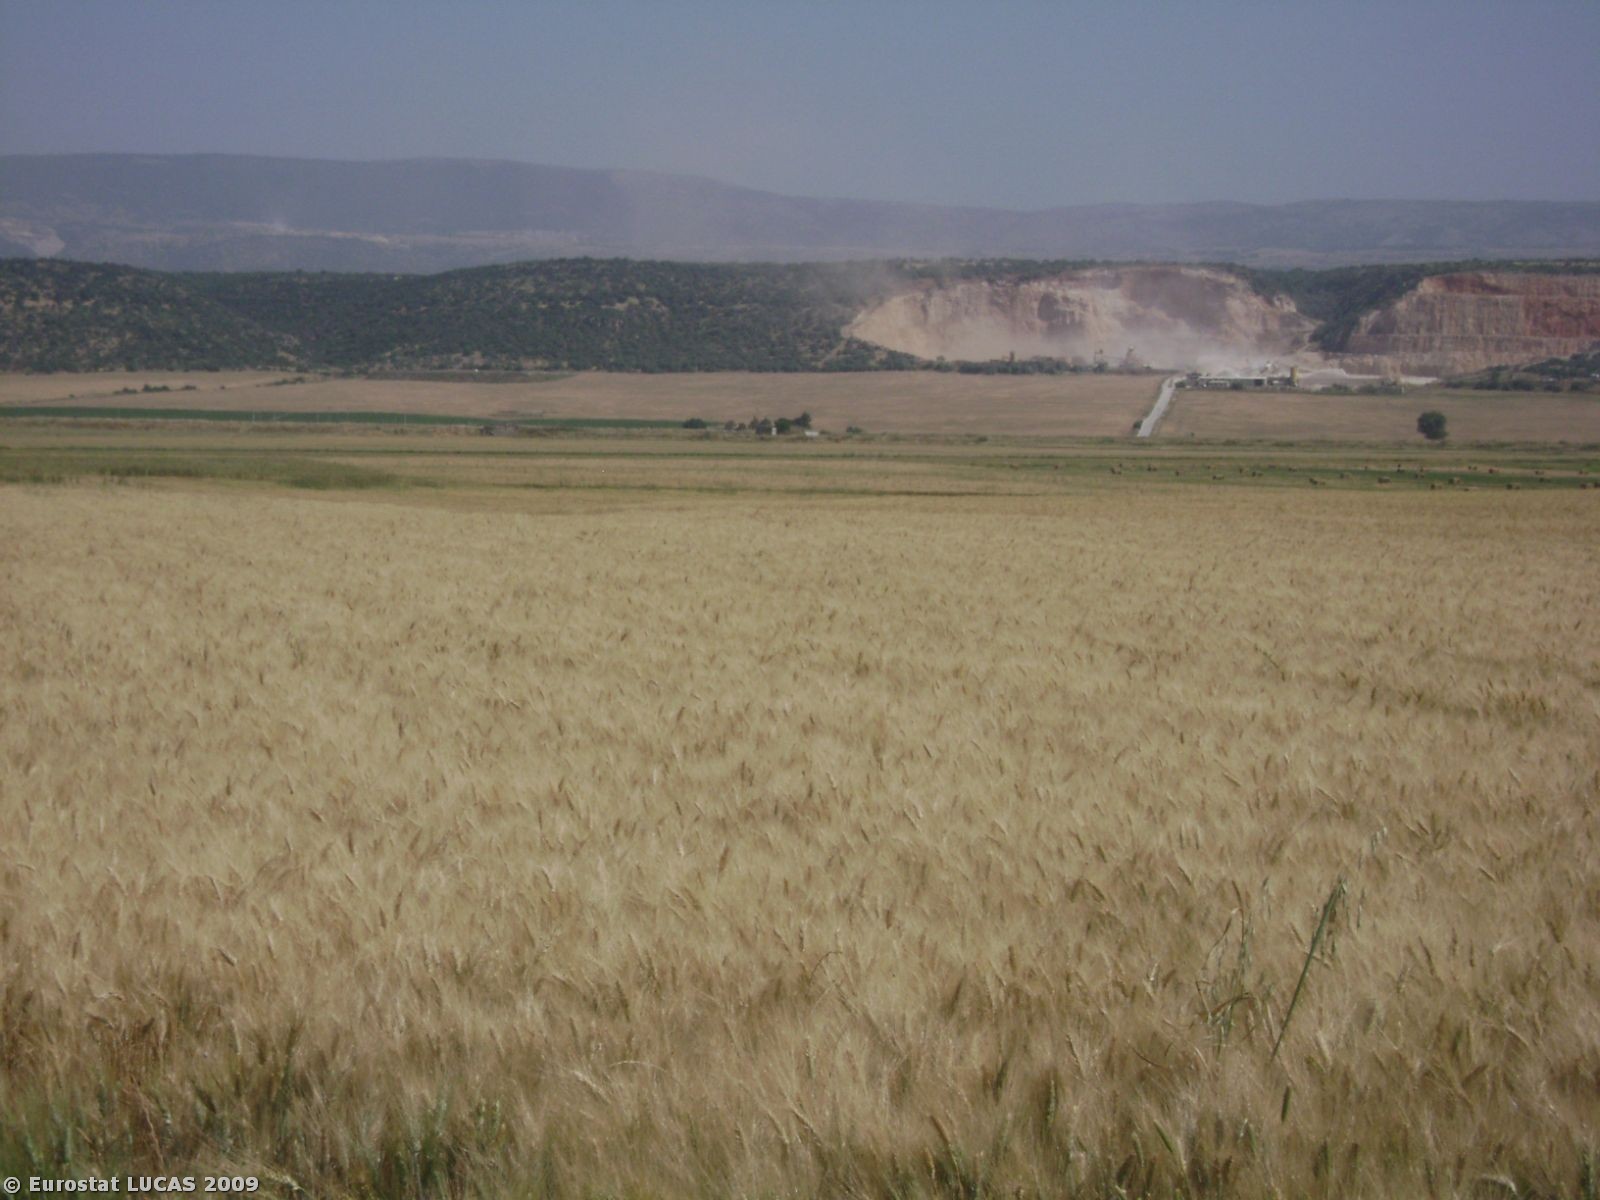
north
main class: Cropland
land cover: Durum wheat
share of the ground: > 75 %
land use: Agriculture (excluding fallow land and kitchen gardens)
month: May
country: IT
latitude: 41.5878
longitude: 15.7042
